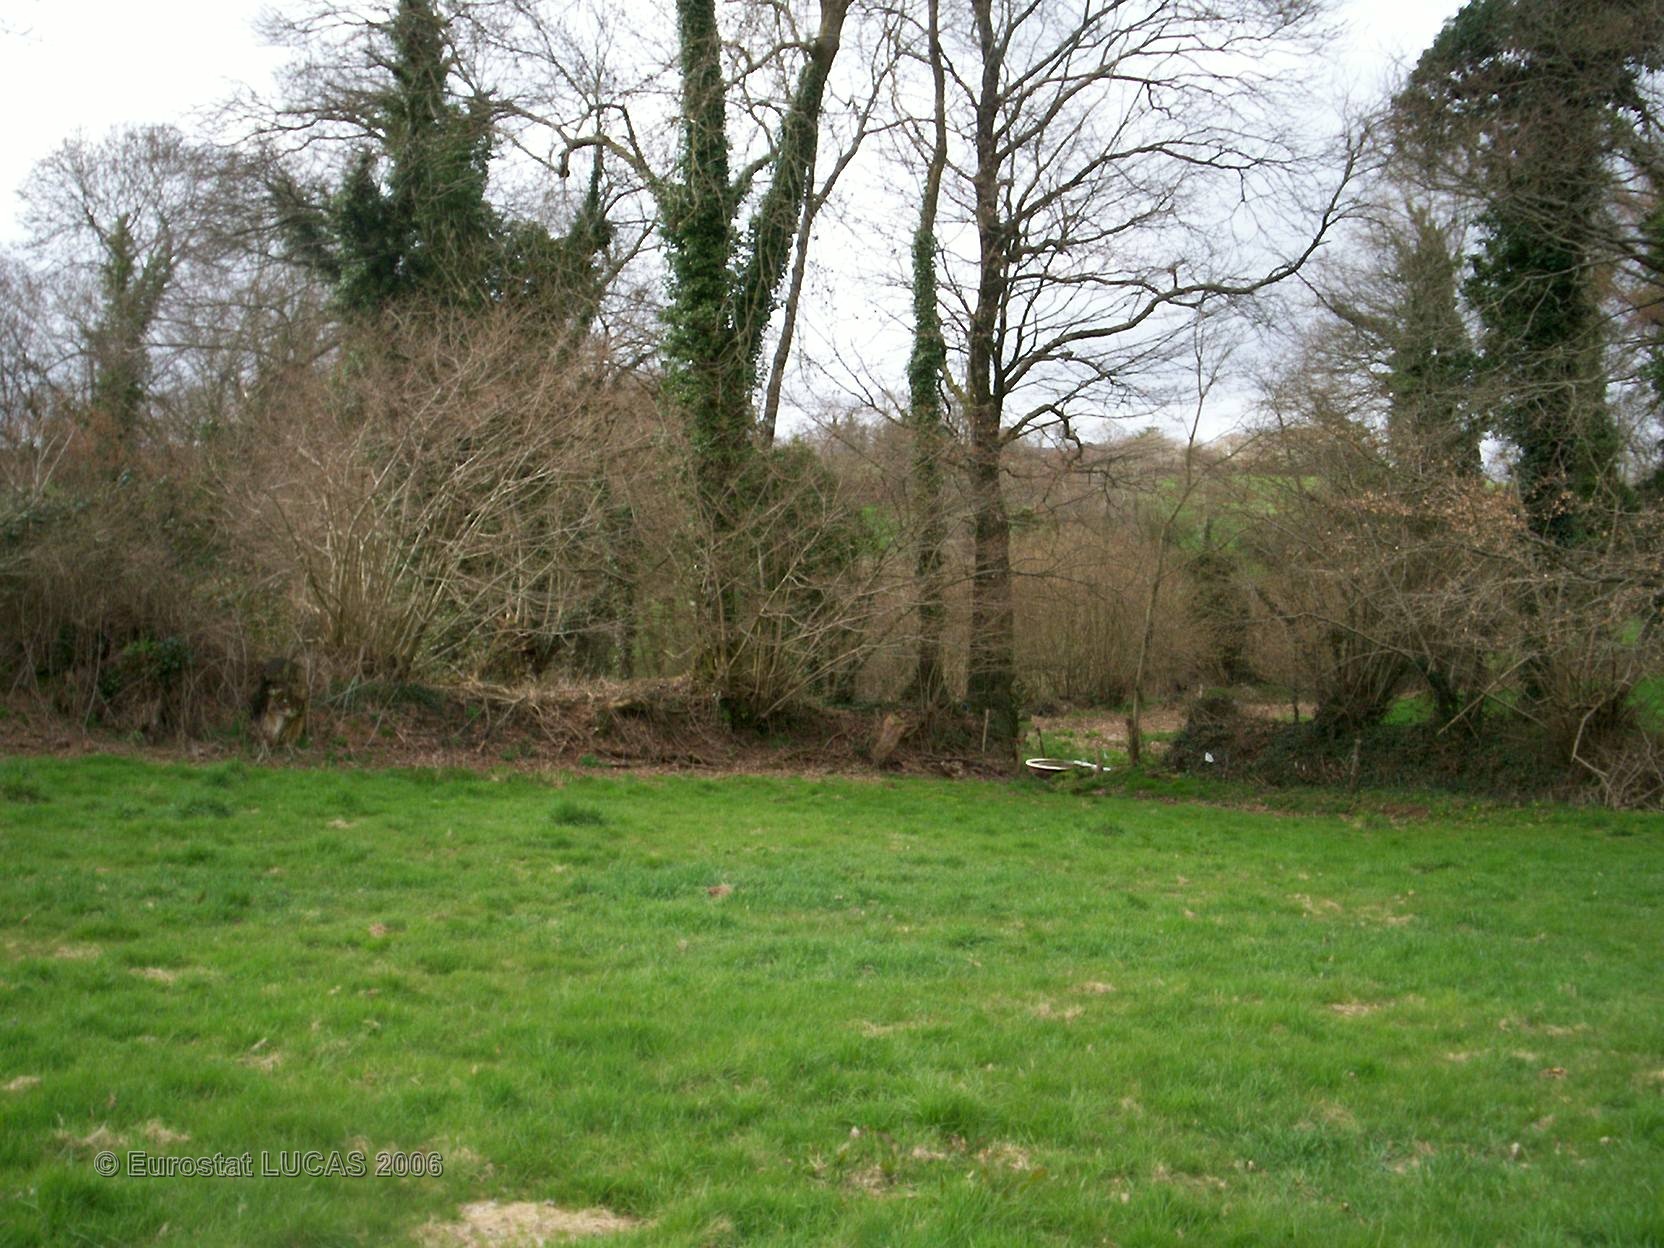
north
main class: Grassland
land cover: Grassland without tree/shrub cover
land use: Agriculture (excluding fallow land and kitchen gardens)
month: April
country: FR
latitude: 48.0667
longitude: -3.6198
